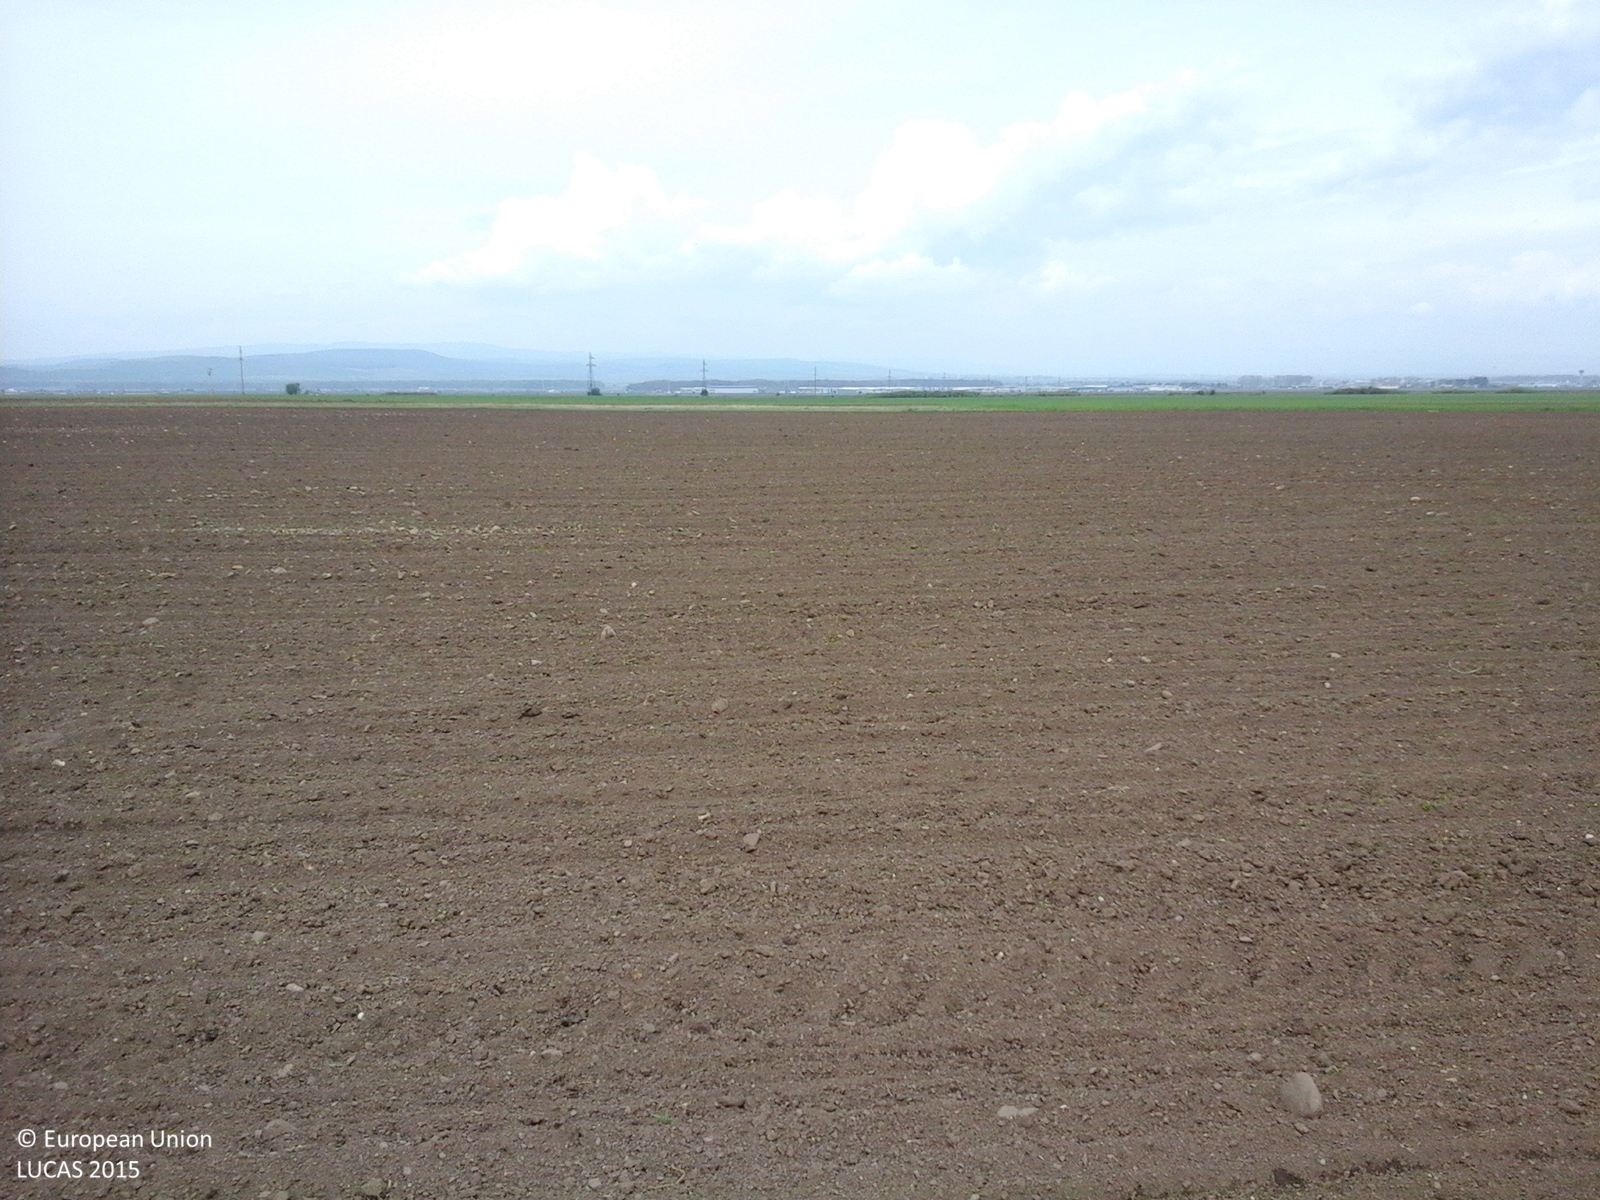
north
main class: Cropland
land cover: Maize
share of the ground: < 10 %
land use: Agriculture (excluding fallow land and kitchen gardens)
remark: Tilled/Sowed
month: May
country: RO
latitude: 45.6907
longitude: 25.7356
